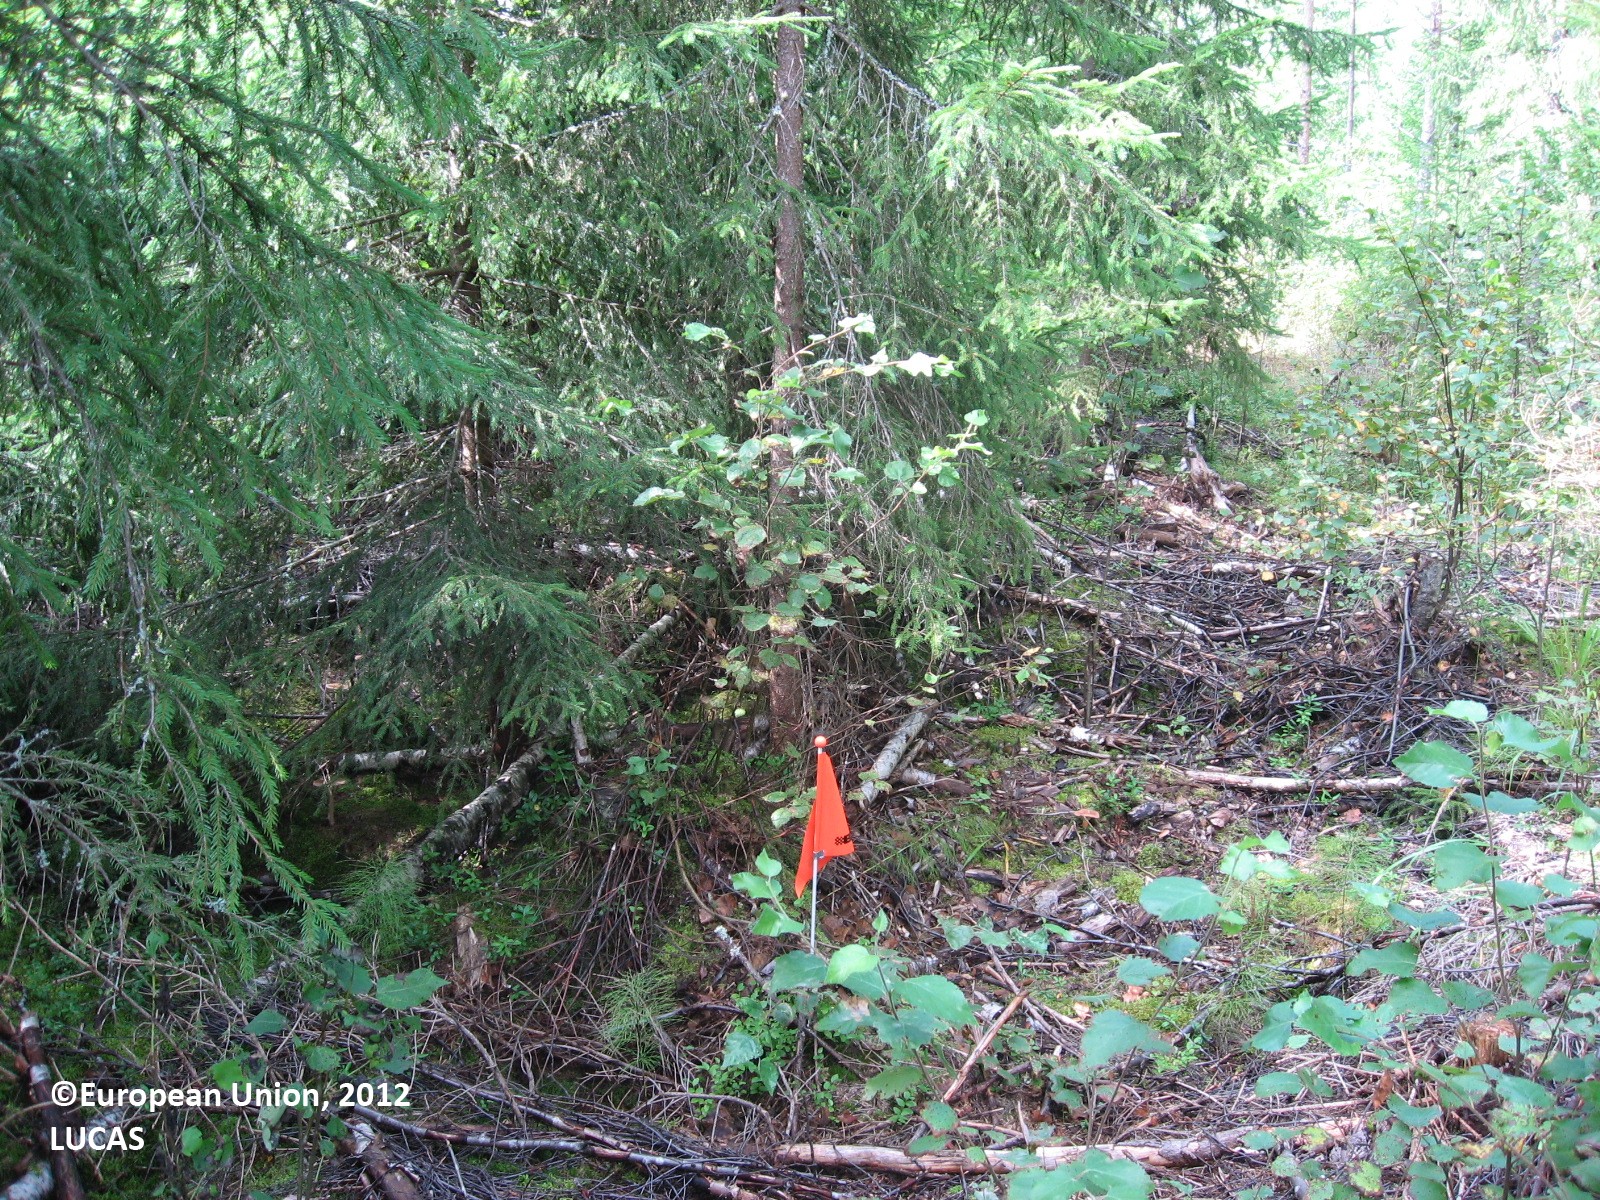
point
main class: Woodland
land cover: Spruce dominated mixed woodland
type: boreal forest
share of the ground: > 75 %
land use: Forestry
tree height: > 5 m
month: August
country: FI
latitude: 60.7882
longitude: 25.1630
